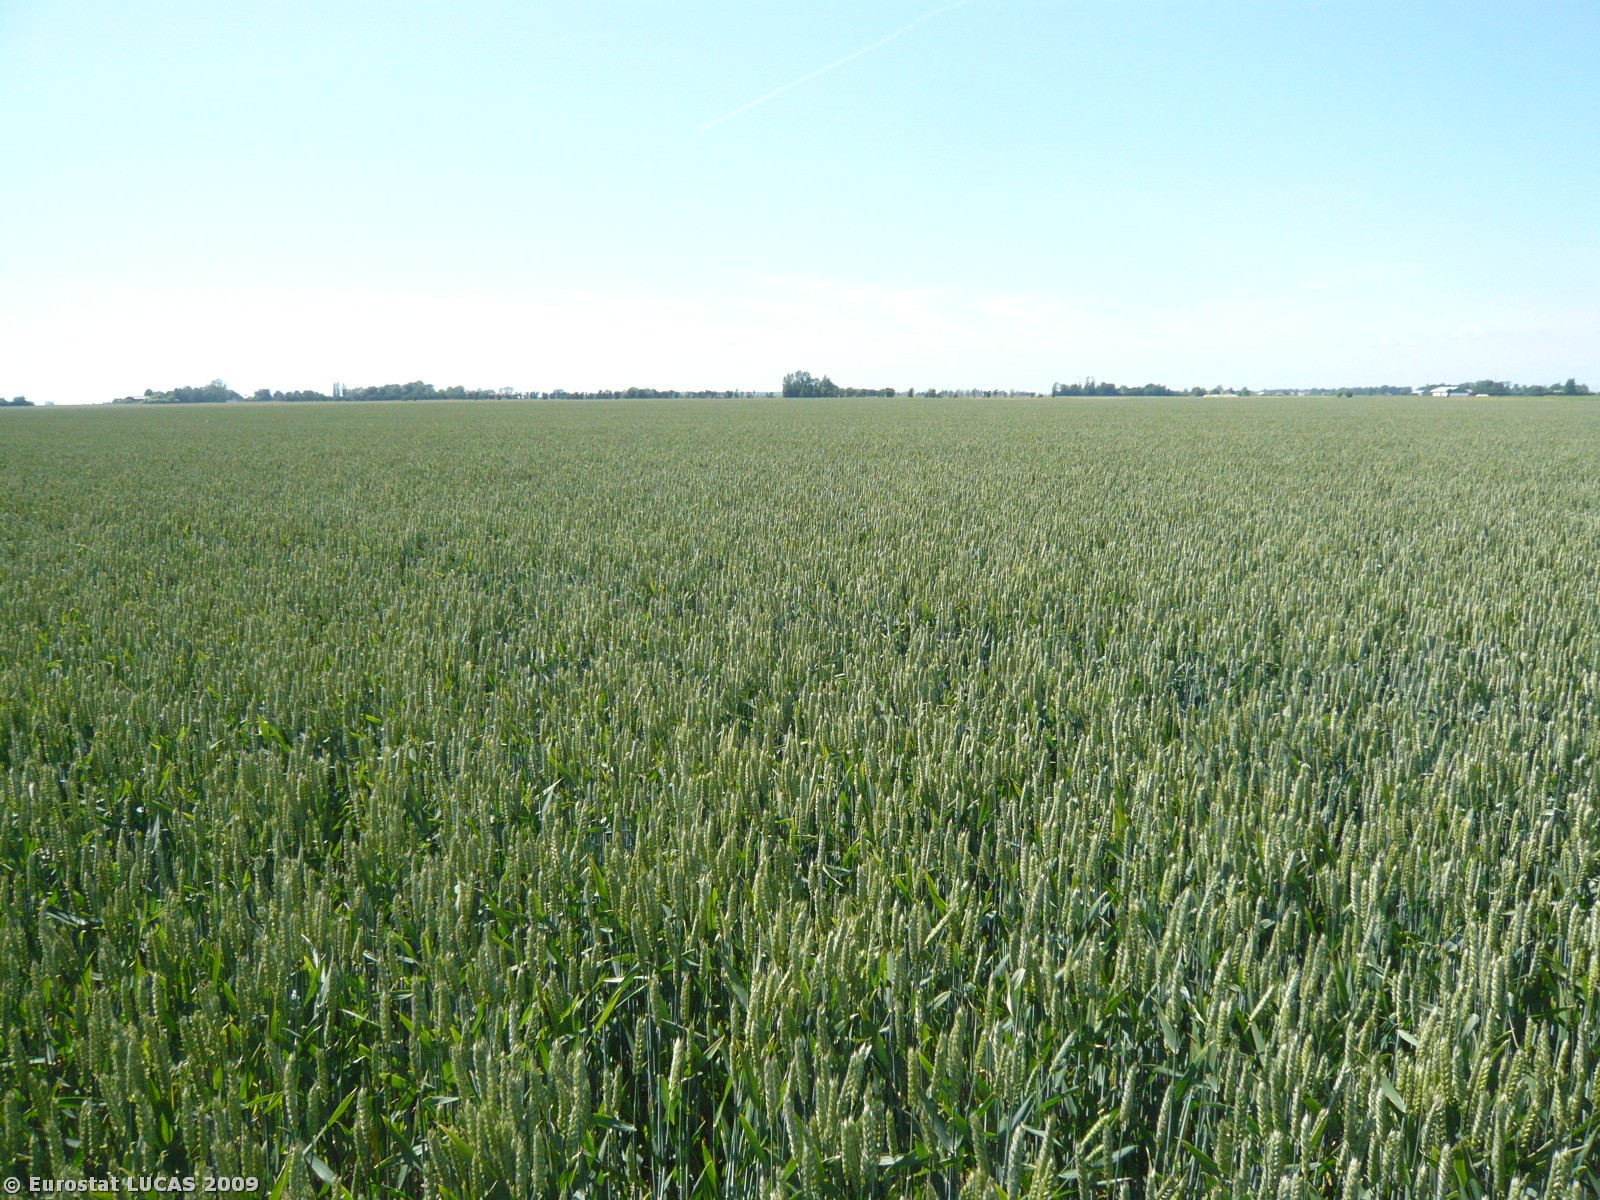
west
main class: Cropland
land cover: Common wheat
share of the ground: > 75 %
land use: Agriculture (excluding fallow land and kitchen gardens)
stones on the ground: < 10 %
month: June
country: DK
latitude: 54.7435
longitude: 11.2574
